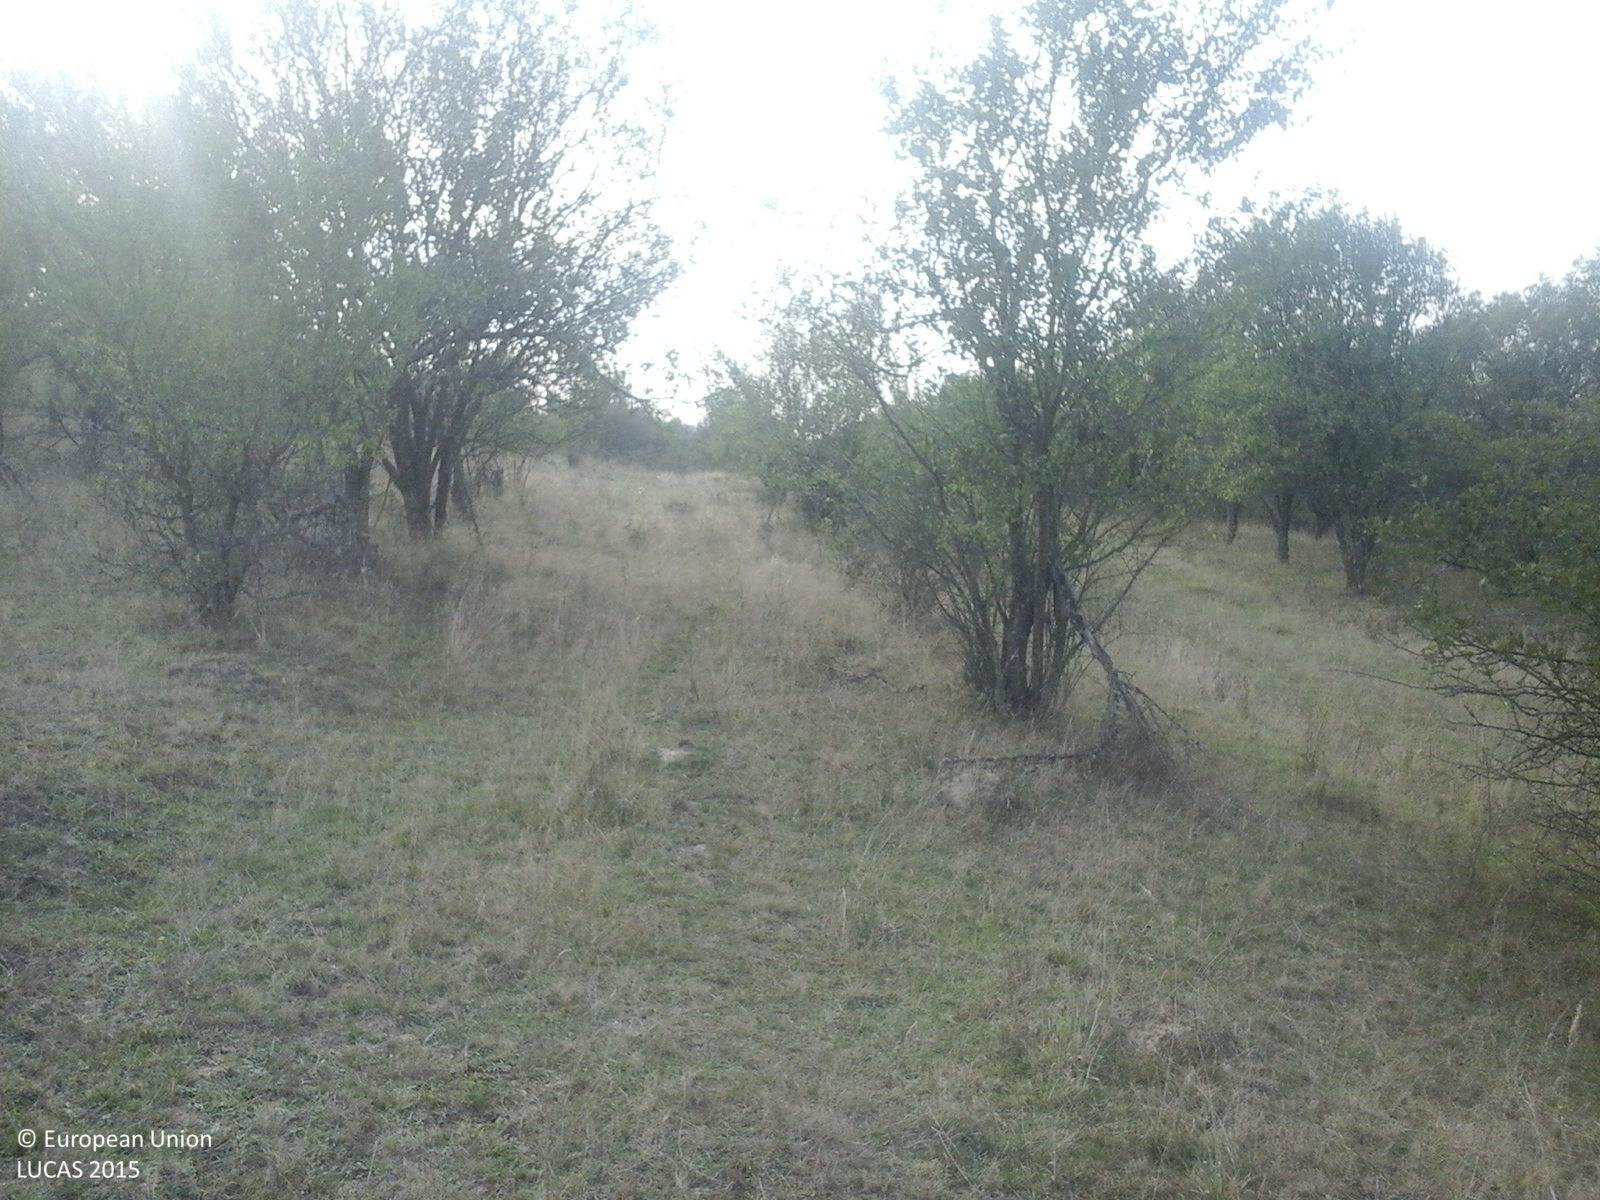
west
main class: Cropland
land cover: Other fruit trees and berries
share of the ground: > 75 %
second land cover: Grassland without tree/shrub cover
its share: > 75 %
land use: Agriculture (excluding fallow land and kitchen gardens)
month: September
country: RO
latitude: 47.0200
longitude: 23.2355
